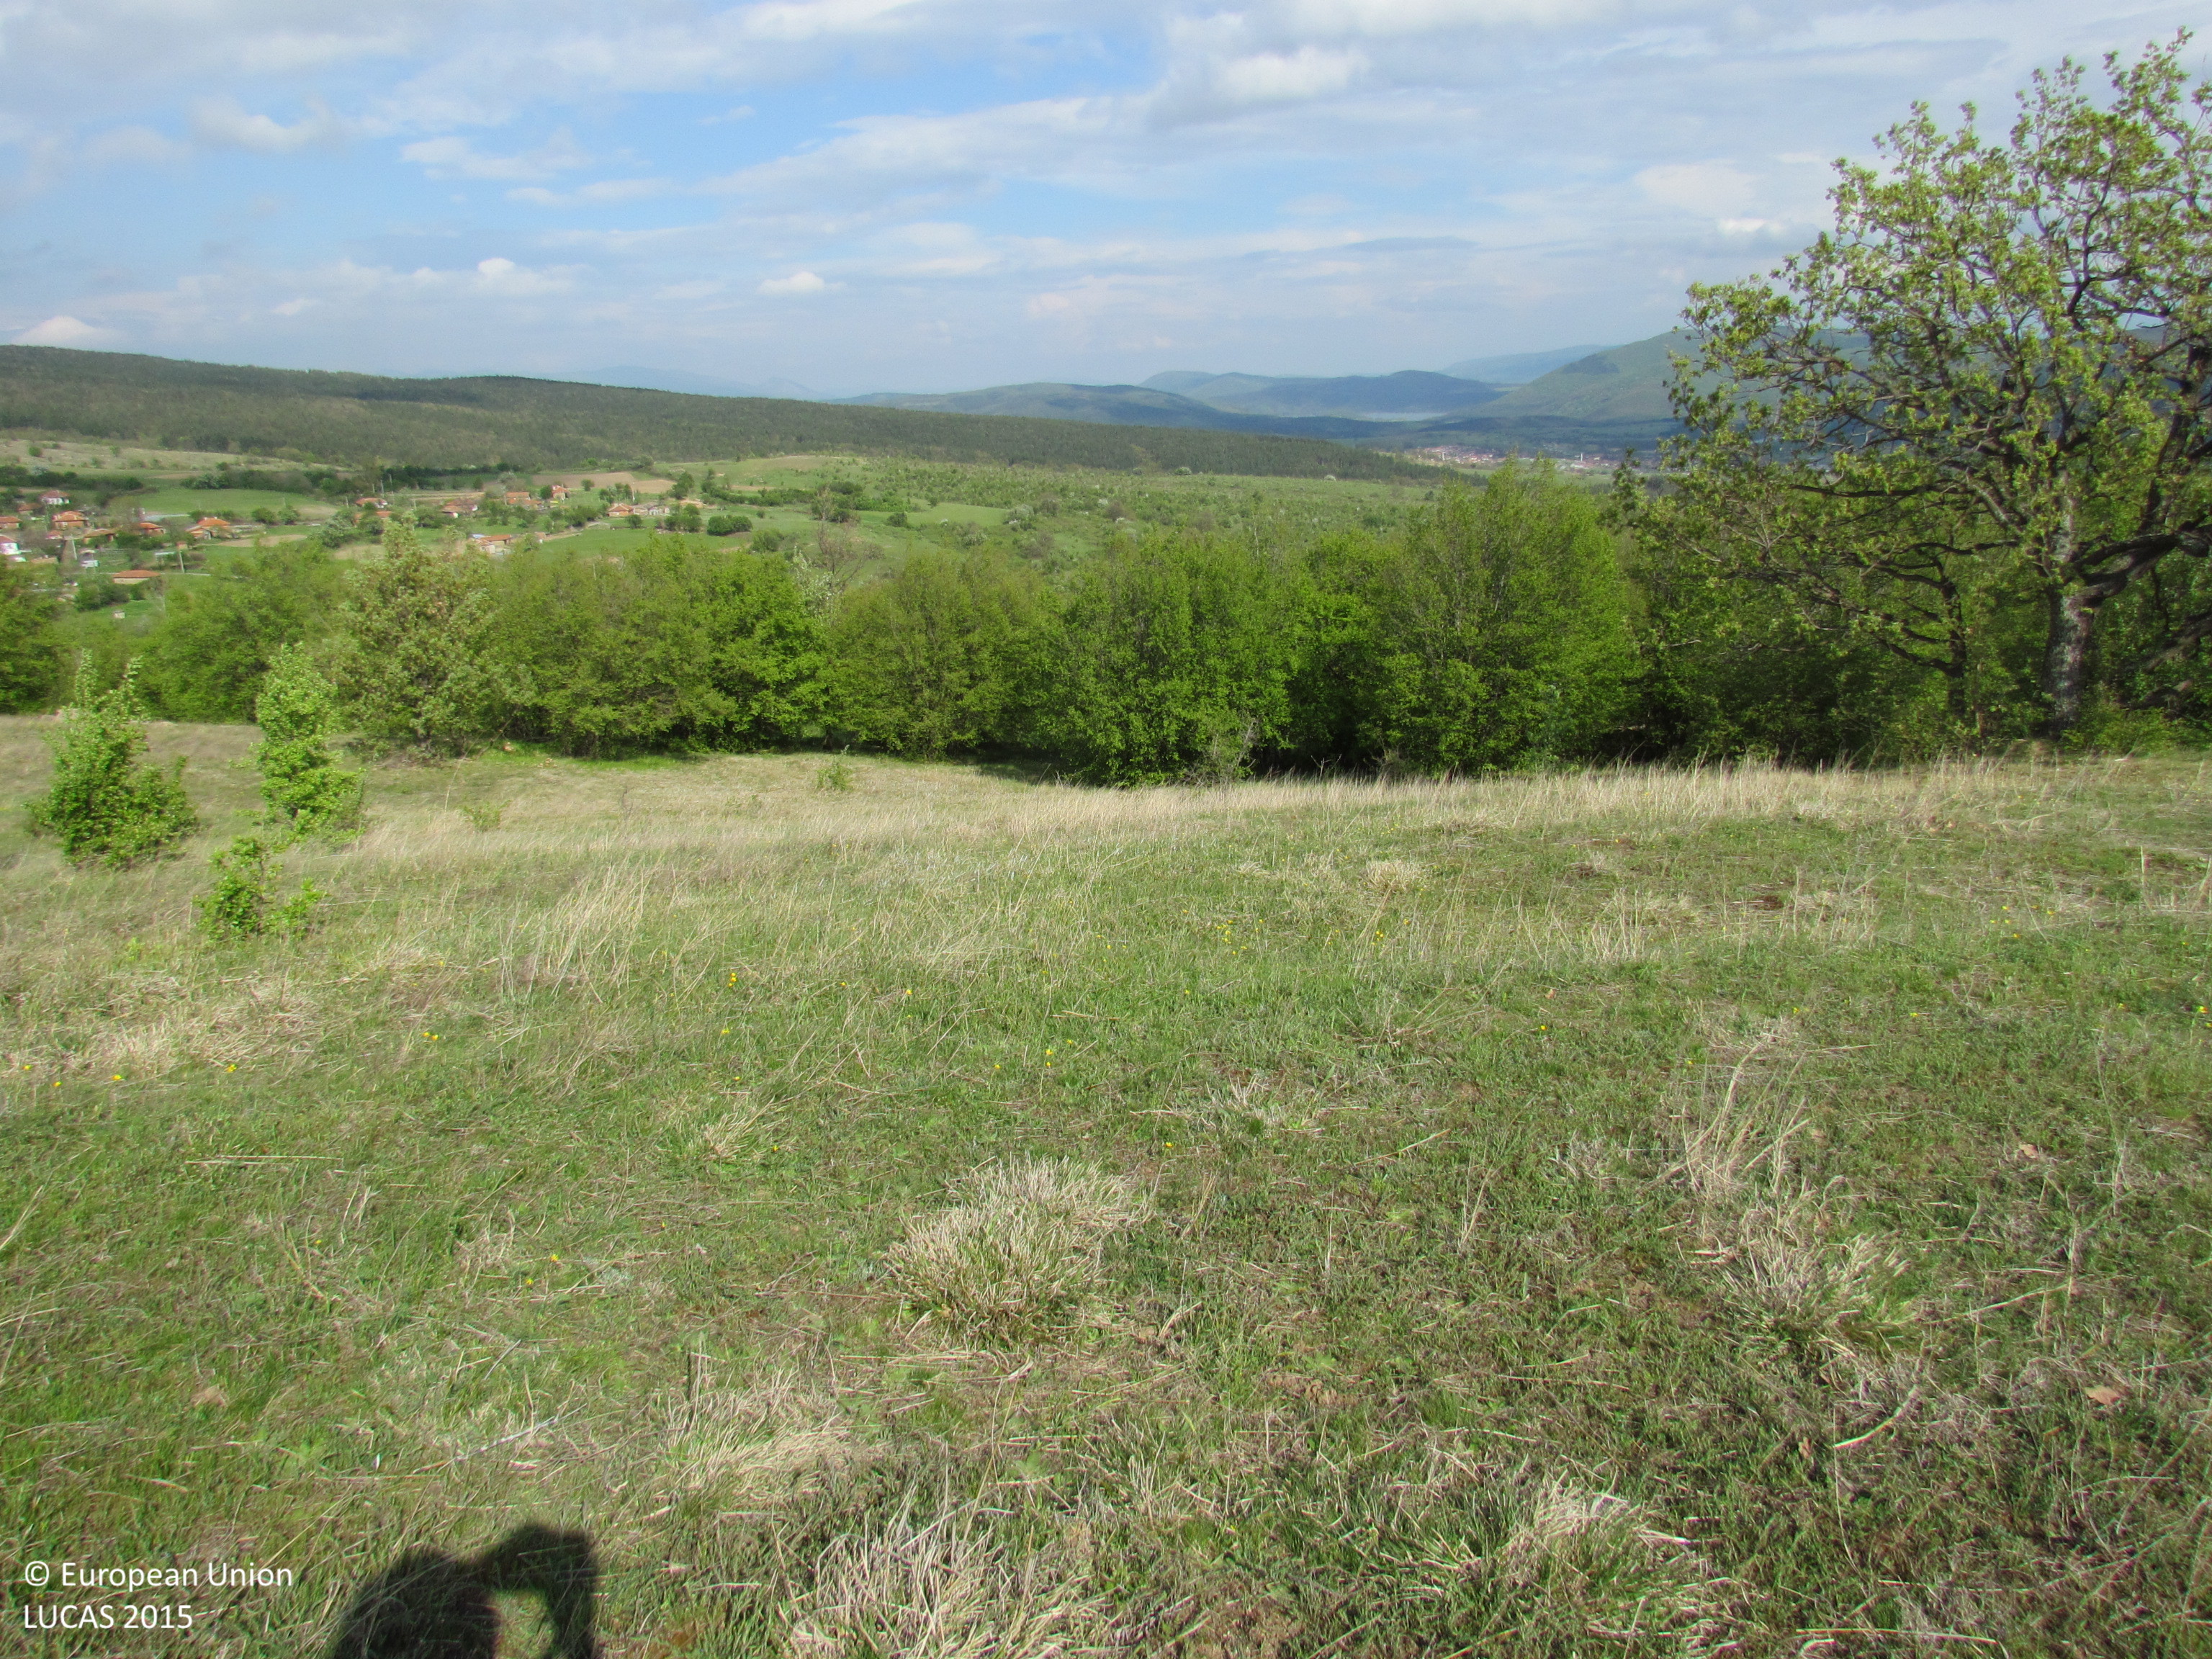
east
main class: Grassland
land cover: Grassland without tree/shrub cover
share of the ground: > 75 %
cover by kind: herbaceous plants 100 %
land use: Agriculture (excluding fallow land and kitchen gardens)
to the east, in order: Grassland without tree/shrub cover; Grassland with sparse tree/shrub cover; Broadleaved woodland; Grassland without tree/shrub cover; Broadleaved woodland; Grassland without tree/shrub cover; Shrubland with sparse tree cover; Grassland without tree/shrub cover; Grassland with sparse tree/shrub cover
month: April
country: BG
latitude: 42.8824
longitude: 26.7670
